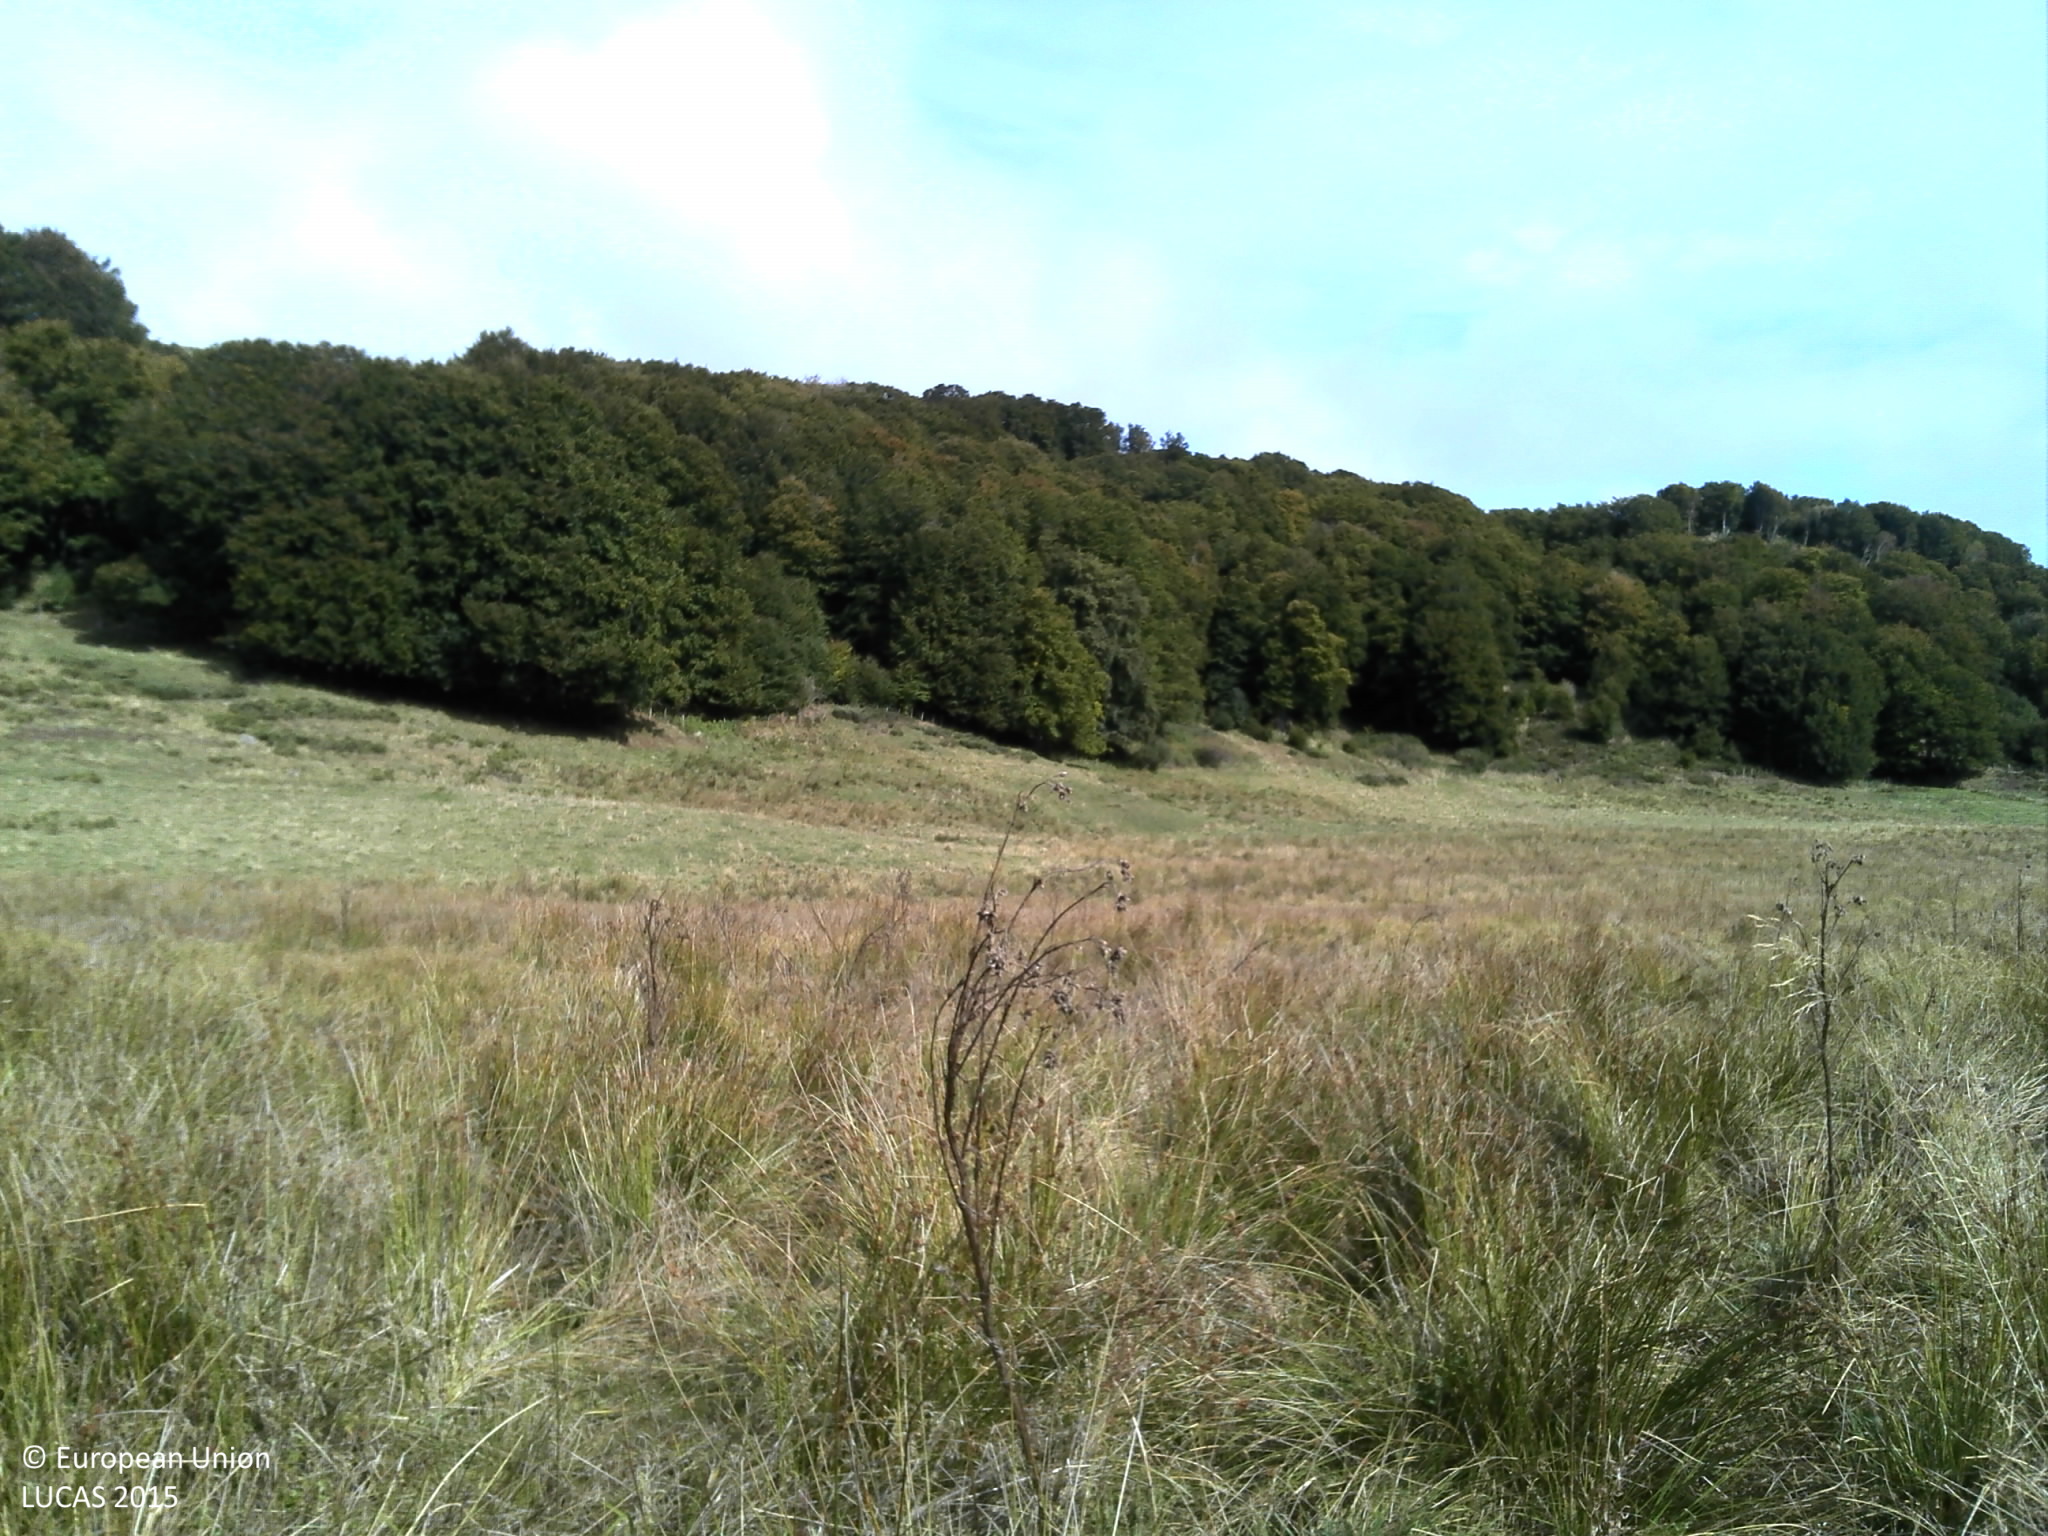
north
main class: Grassland
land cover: Grassland without tree/shrub cover
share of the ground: > 75 %
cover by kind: herbaceous plants 100 %
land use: Agriculture (excluding fallow land and kitchen gardens)
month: September
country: FR
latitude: 45.4984
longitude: 2.8718
